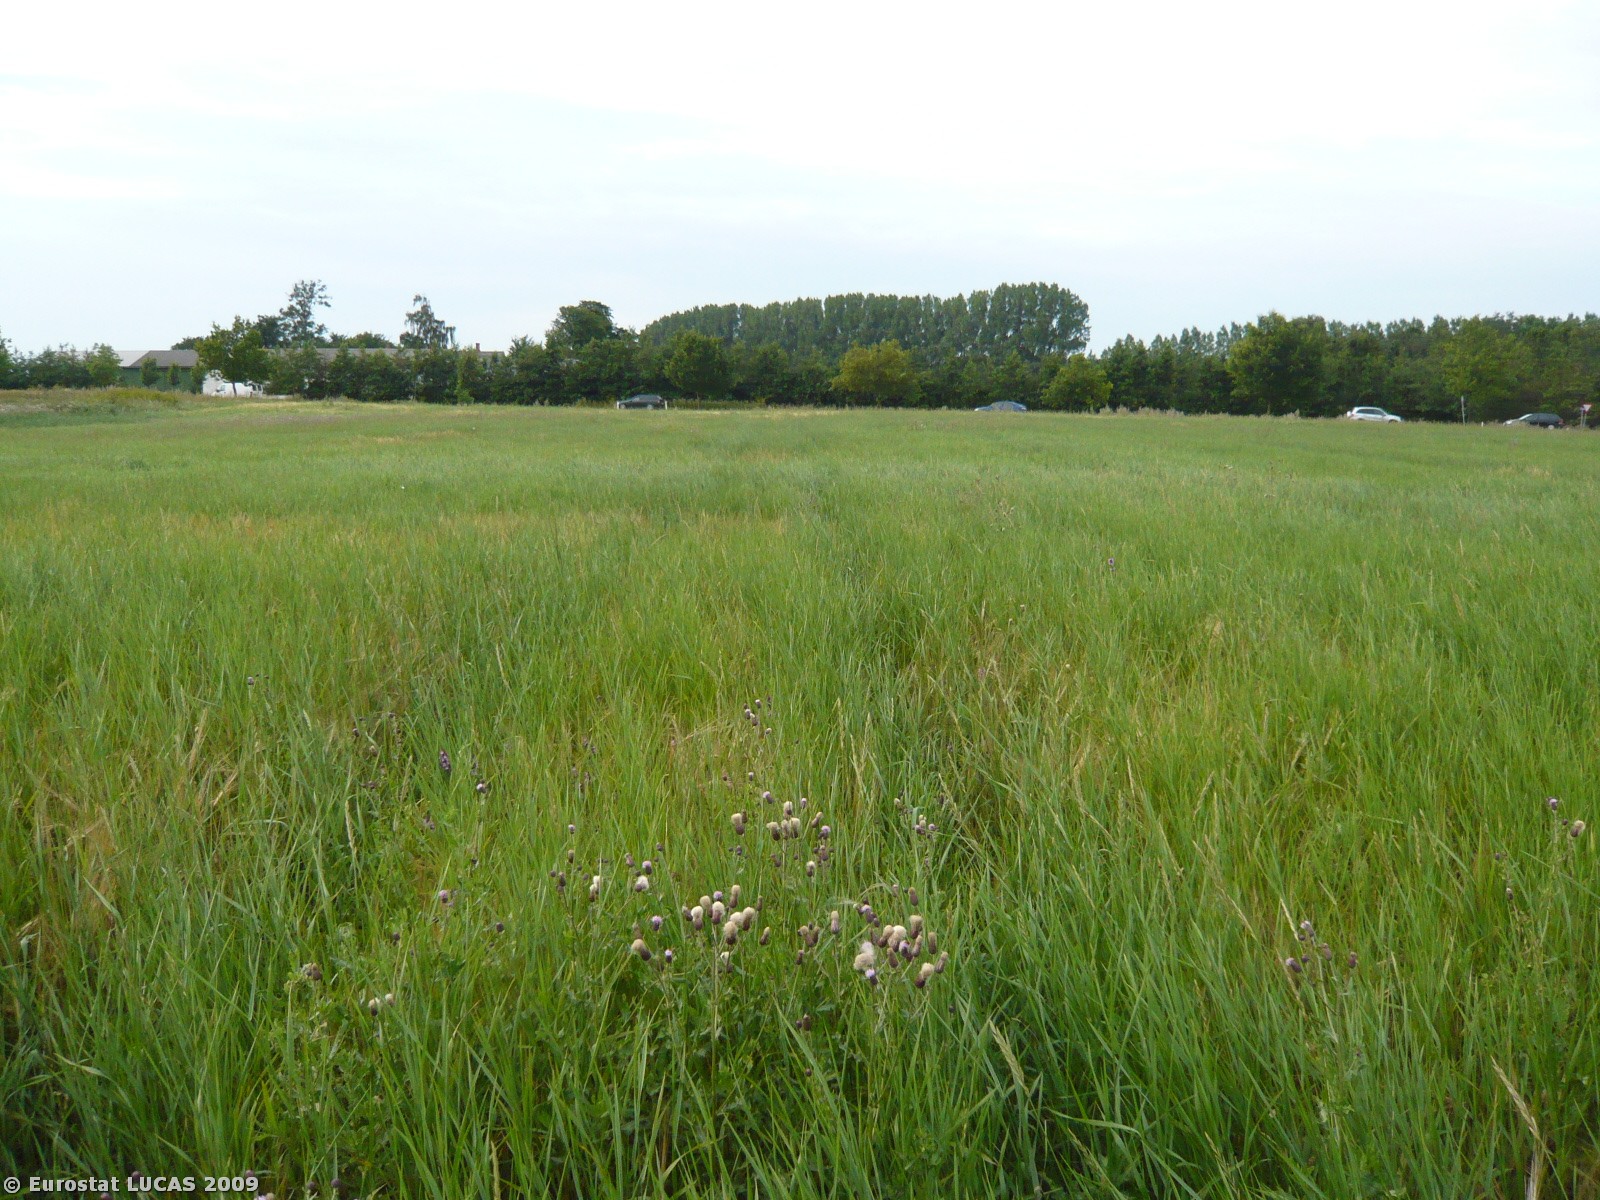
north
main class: Grassland
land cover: Spontaneously vegetated surfaces
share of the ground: > 75 %
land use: Fallow land
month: July
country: DK
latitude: 55.9358
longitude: 12.1591
